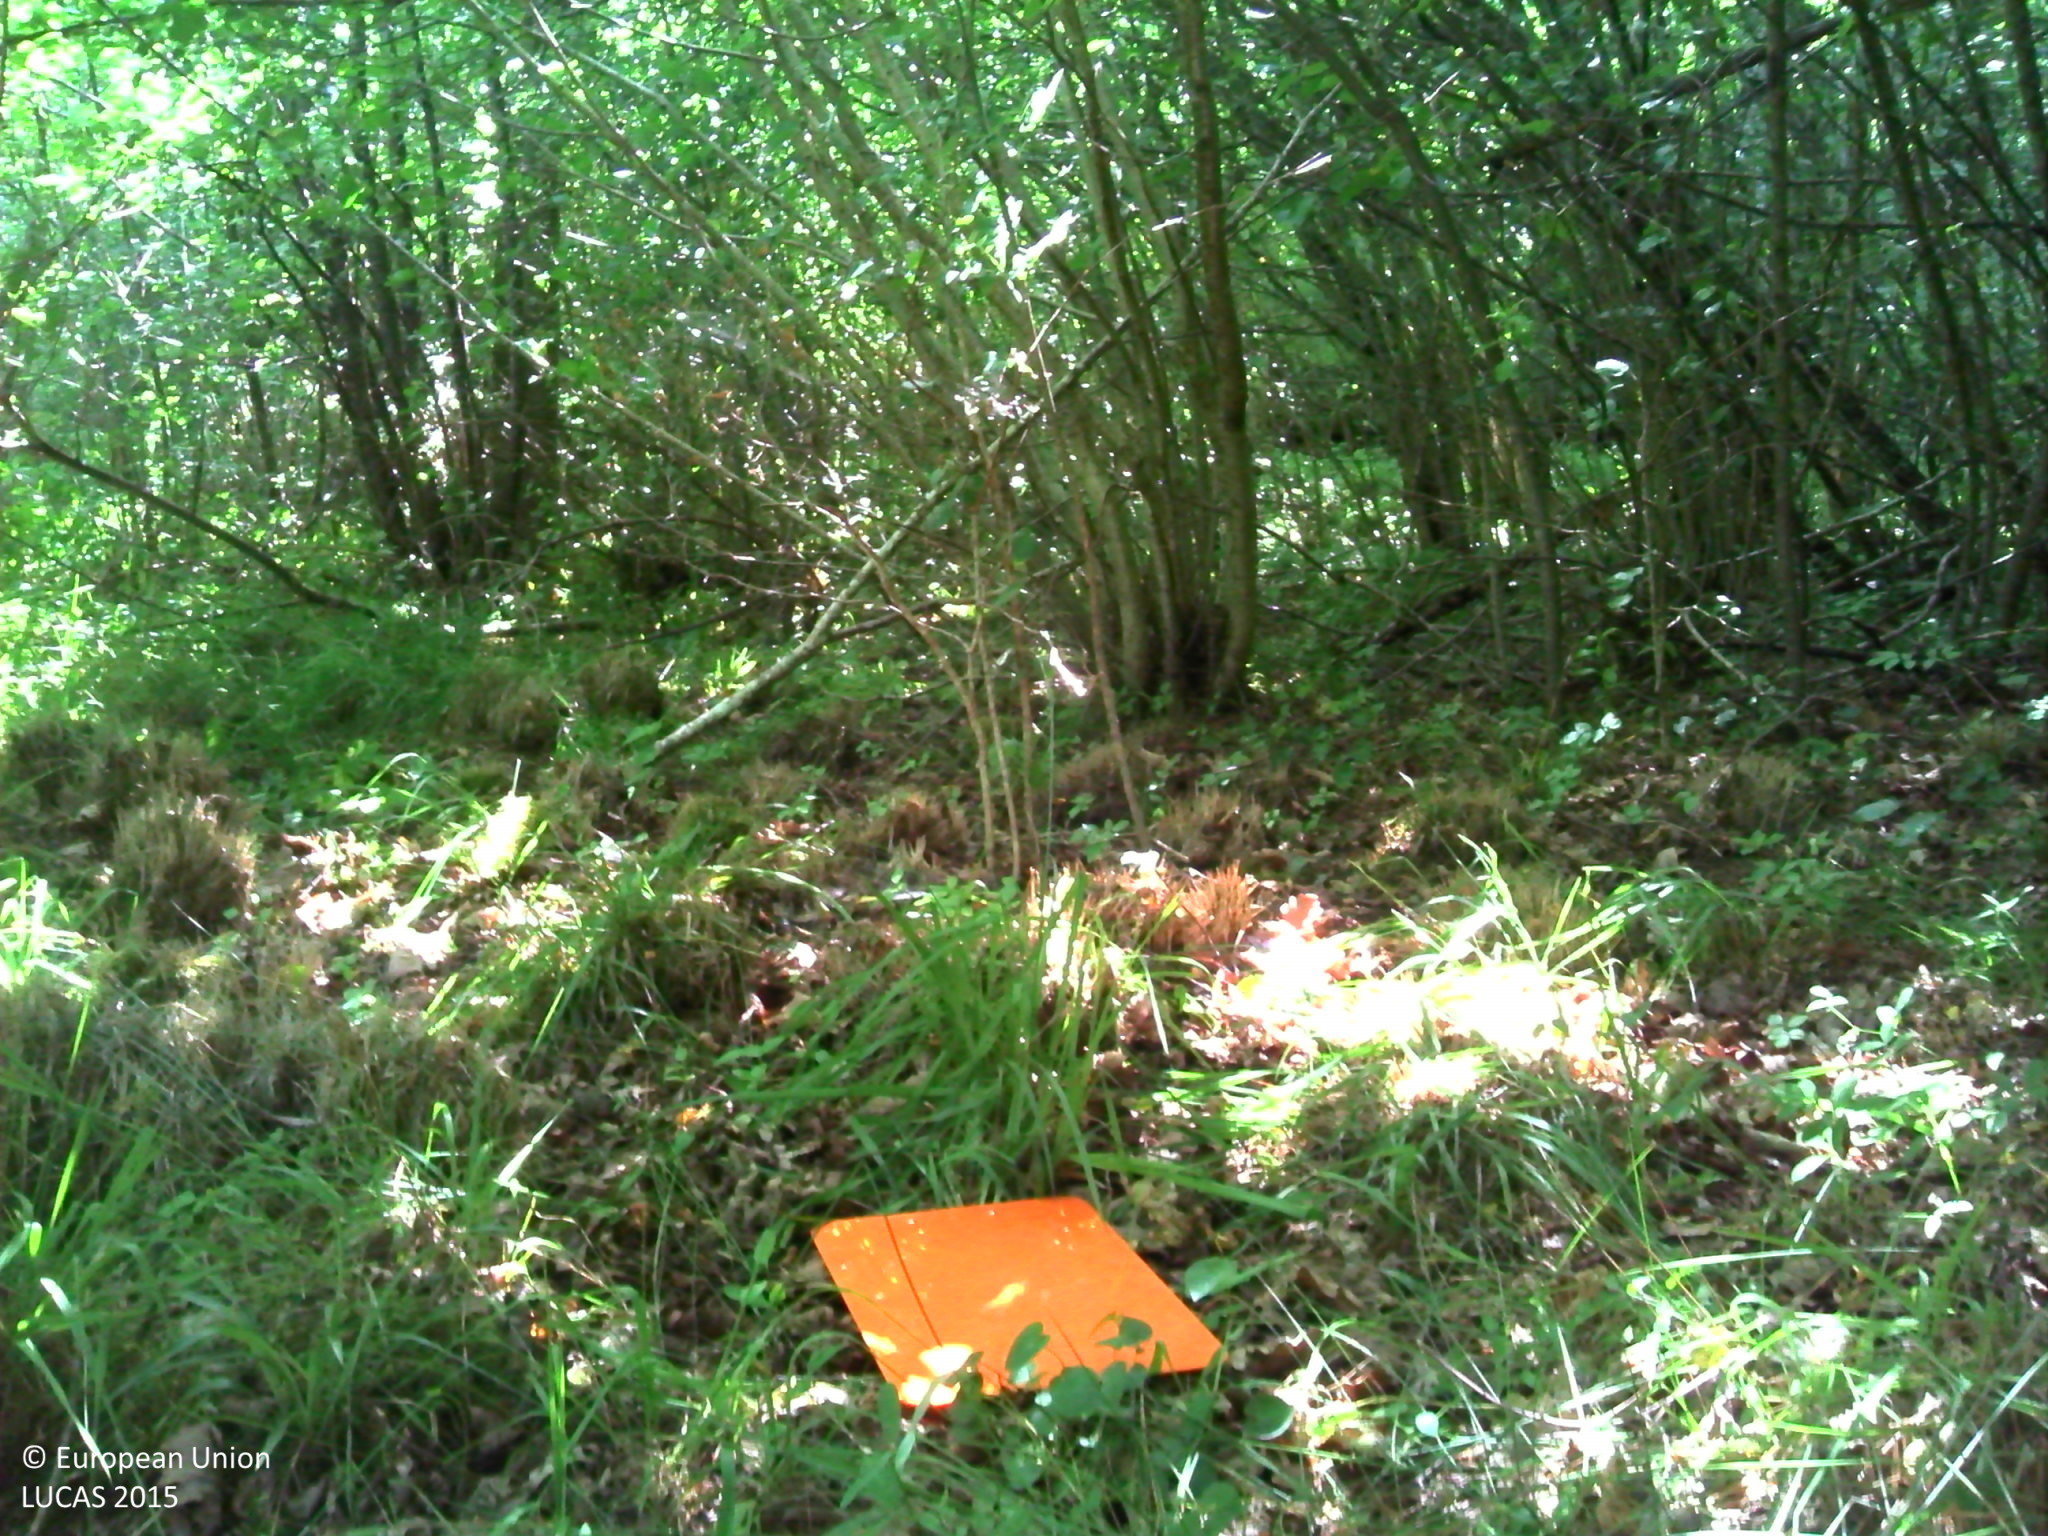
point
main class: Woodland
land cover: Broadleaved woodland
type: mesophytic deciduous forest
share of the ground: > 75 %
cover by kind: broadleaved forest trees 100 %
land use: Forestry
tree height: > 5 m
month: July
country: FR
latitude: 43.6321
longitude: 2.5823
